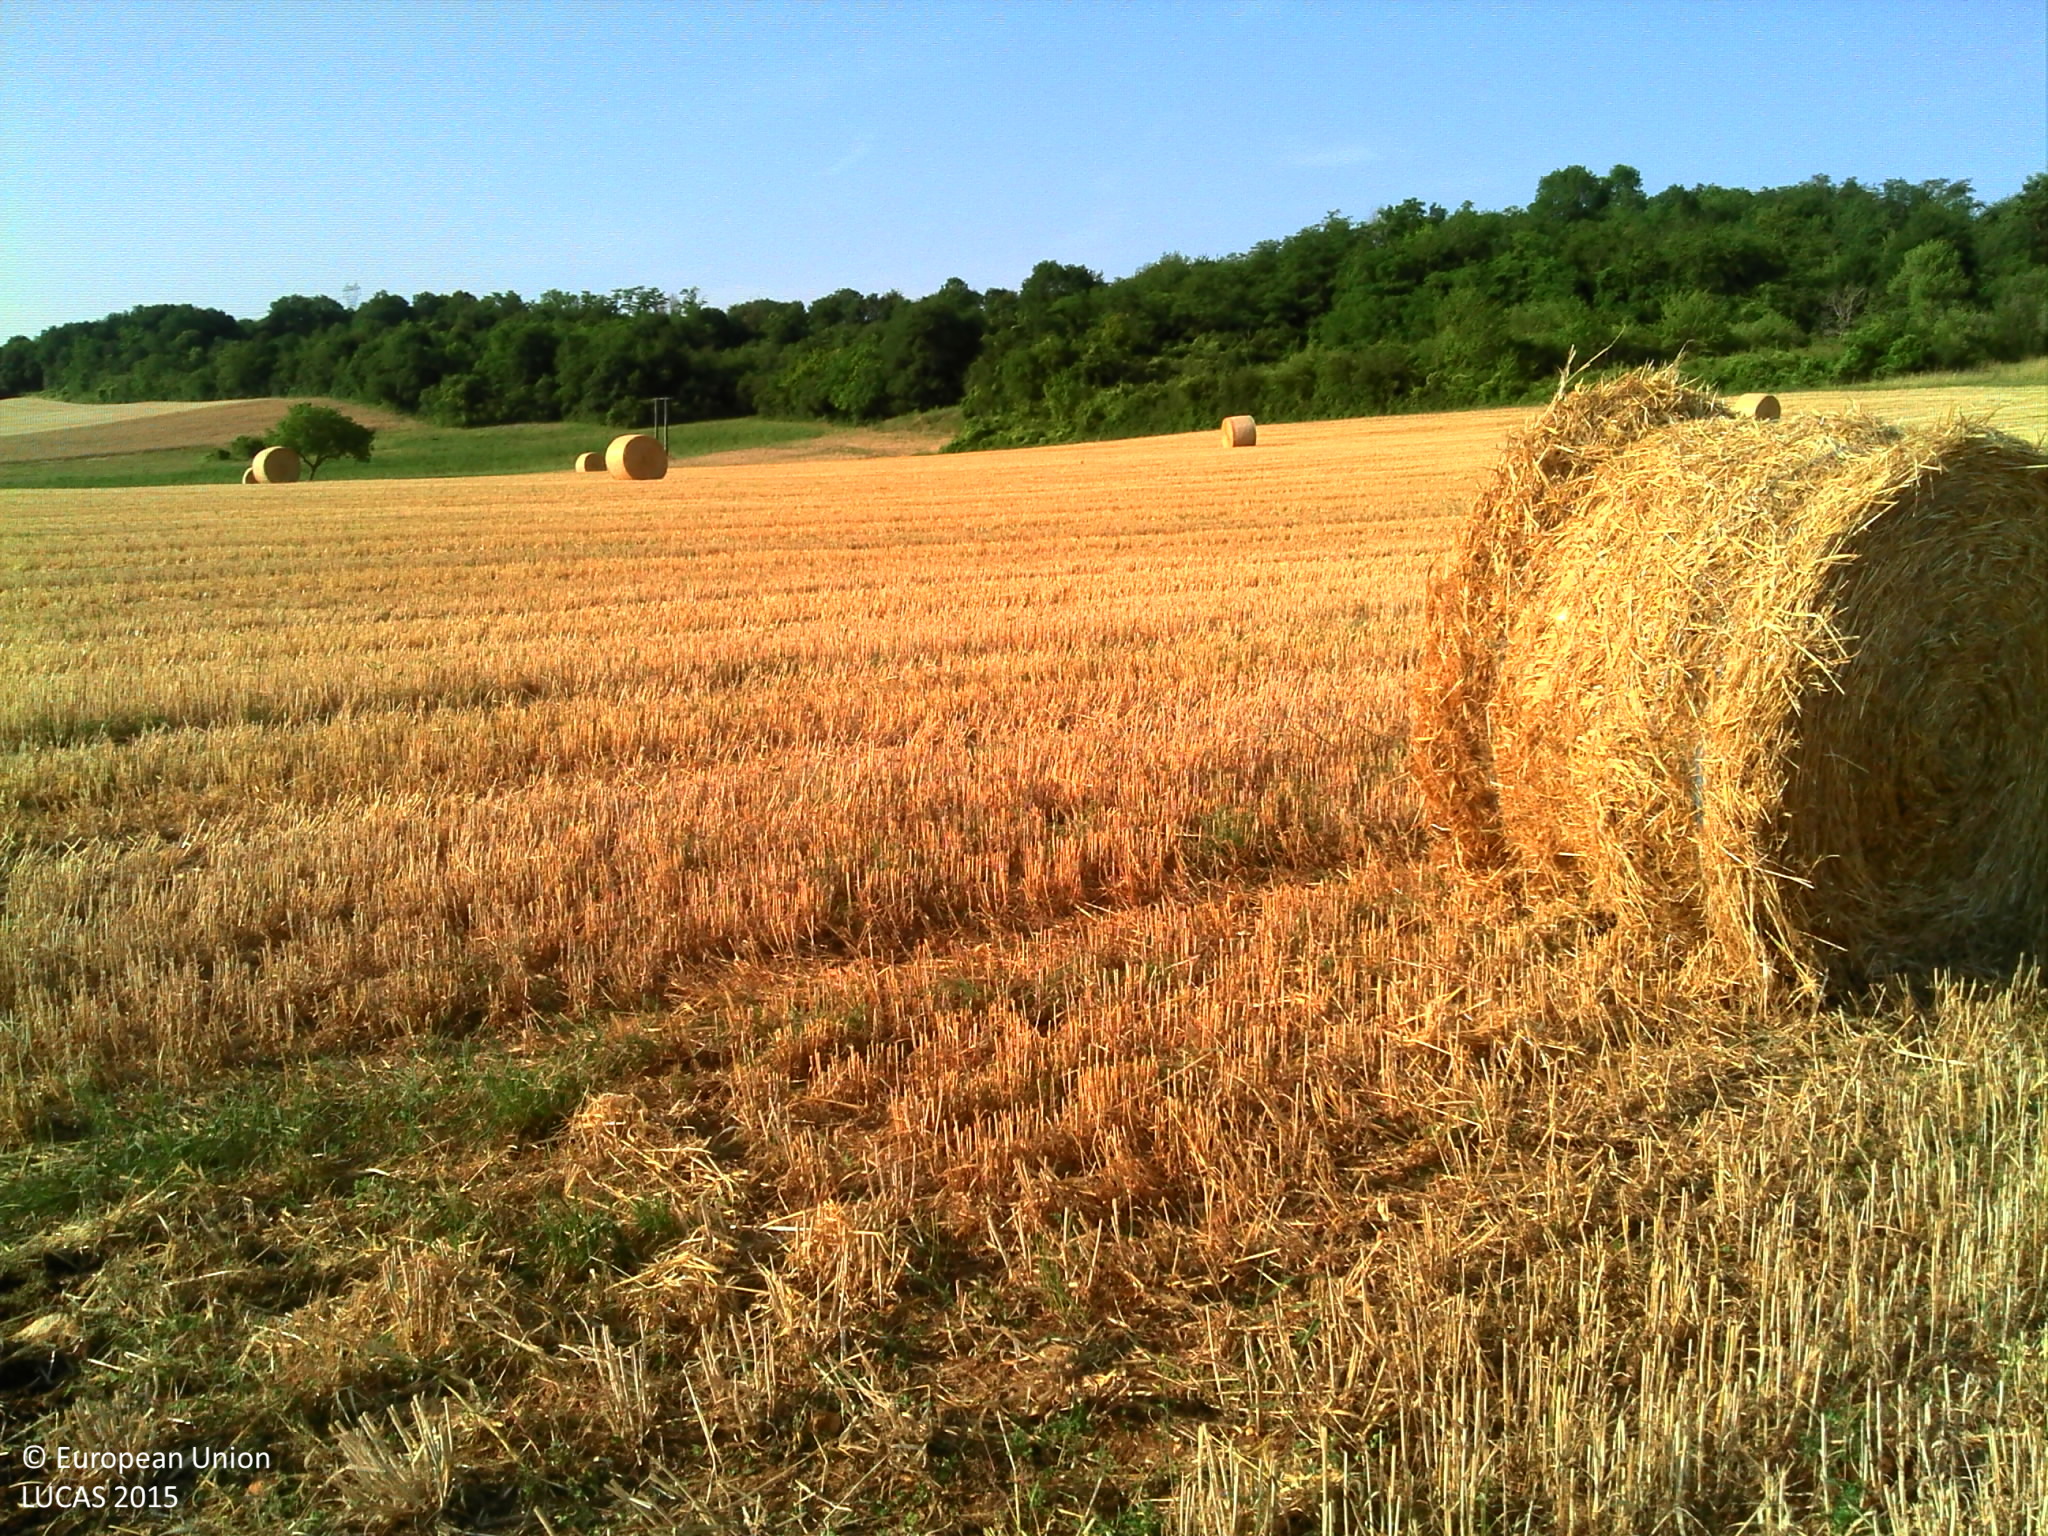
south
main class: Cropland
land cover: Barley
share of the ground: > 75 %
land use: Agriculture (excluding fallow land and kitchen gardens)
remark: Harvested field
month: July
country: FR
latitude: 47.2737
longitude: 3.5064
